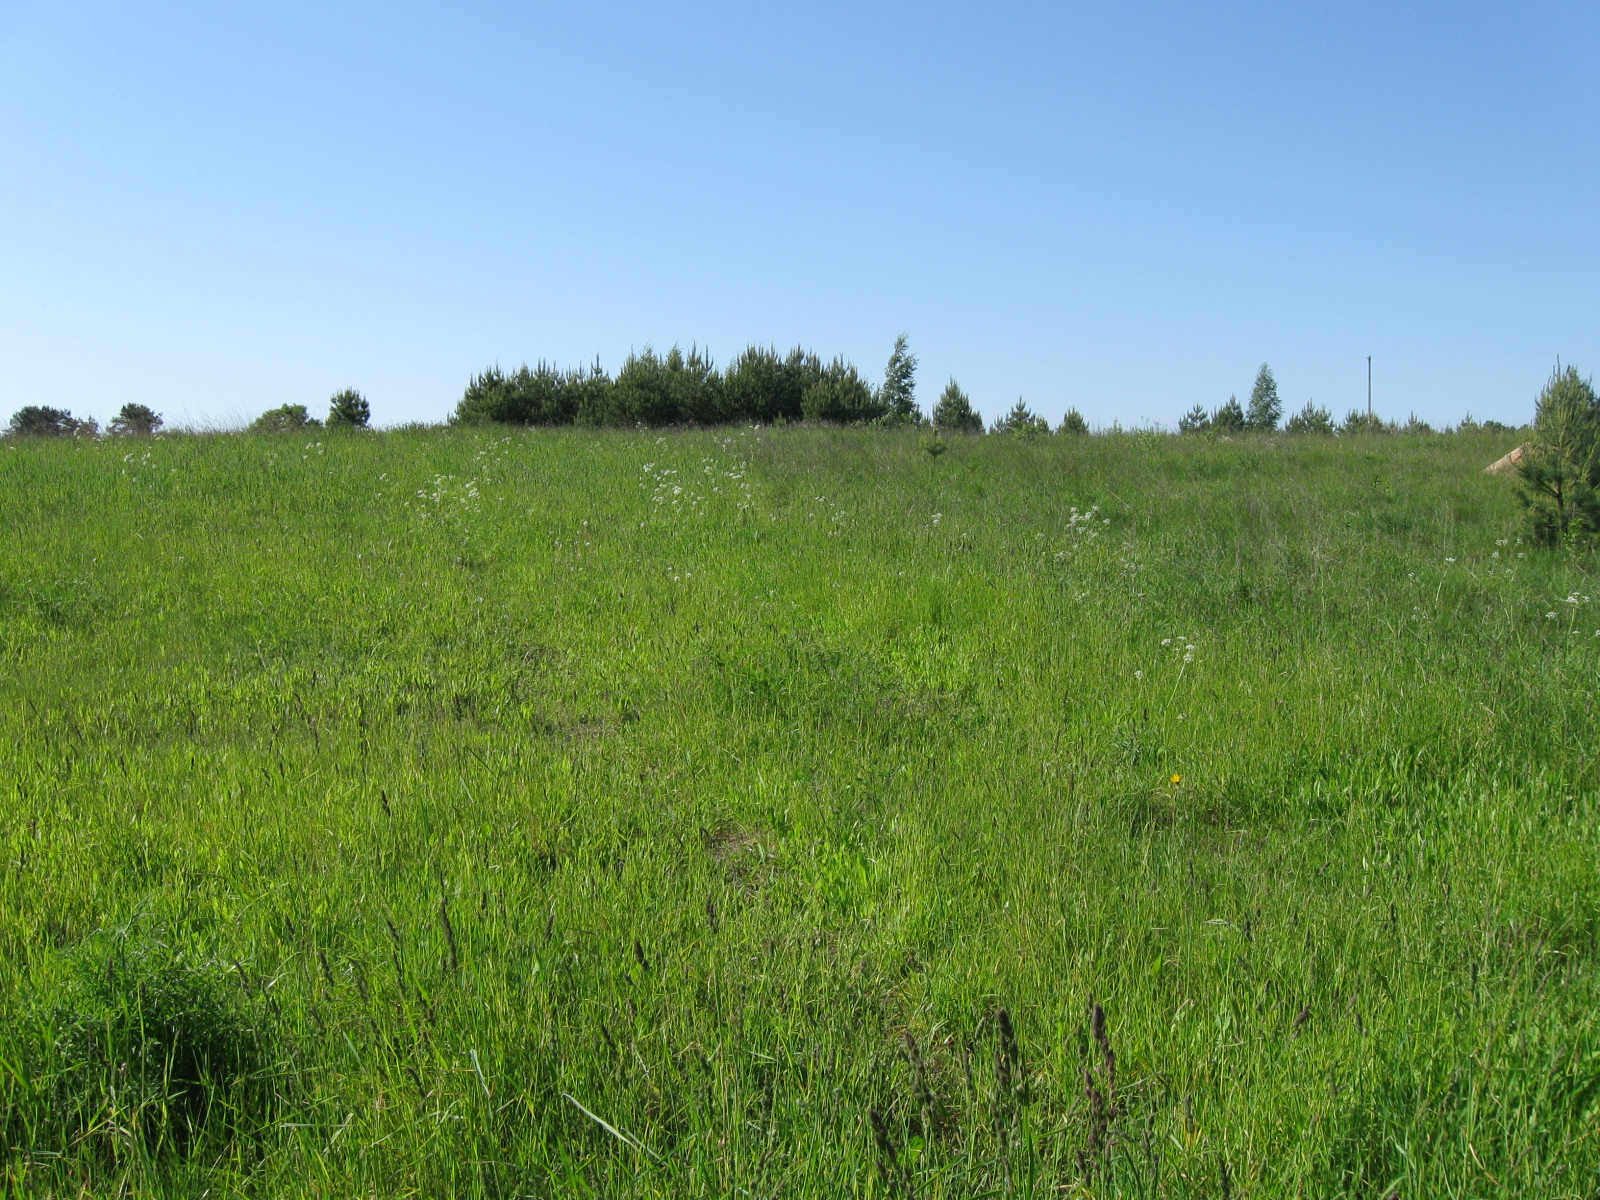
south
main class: Grassland
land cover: Grassland without tree/shrub cover
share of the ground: > 75 %
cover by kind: herbaceous plants 100 %
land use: Agriculture (excluding fallow land and kitchen gardens)
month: June
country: LT
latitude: 54.1753
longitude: 23.4874
